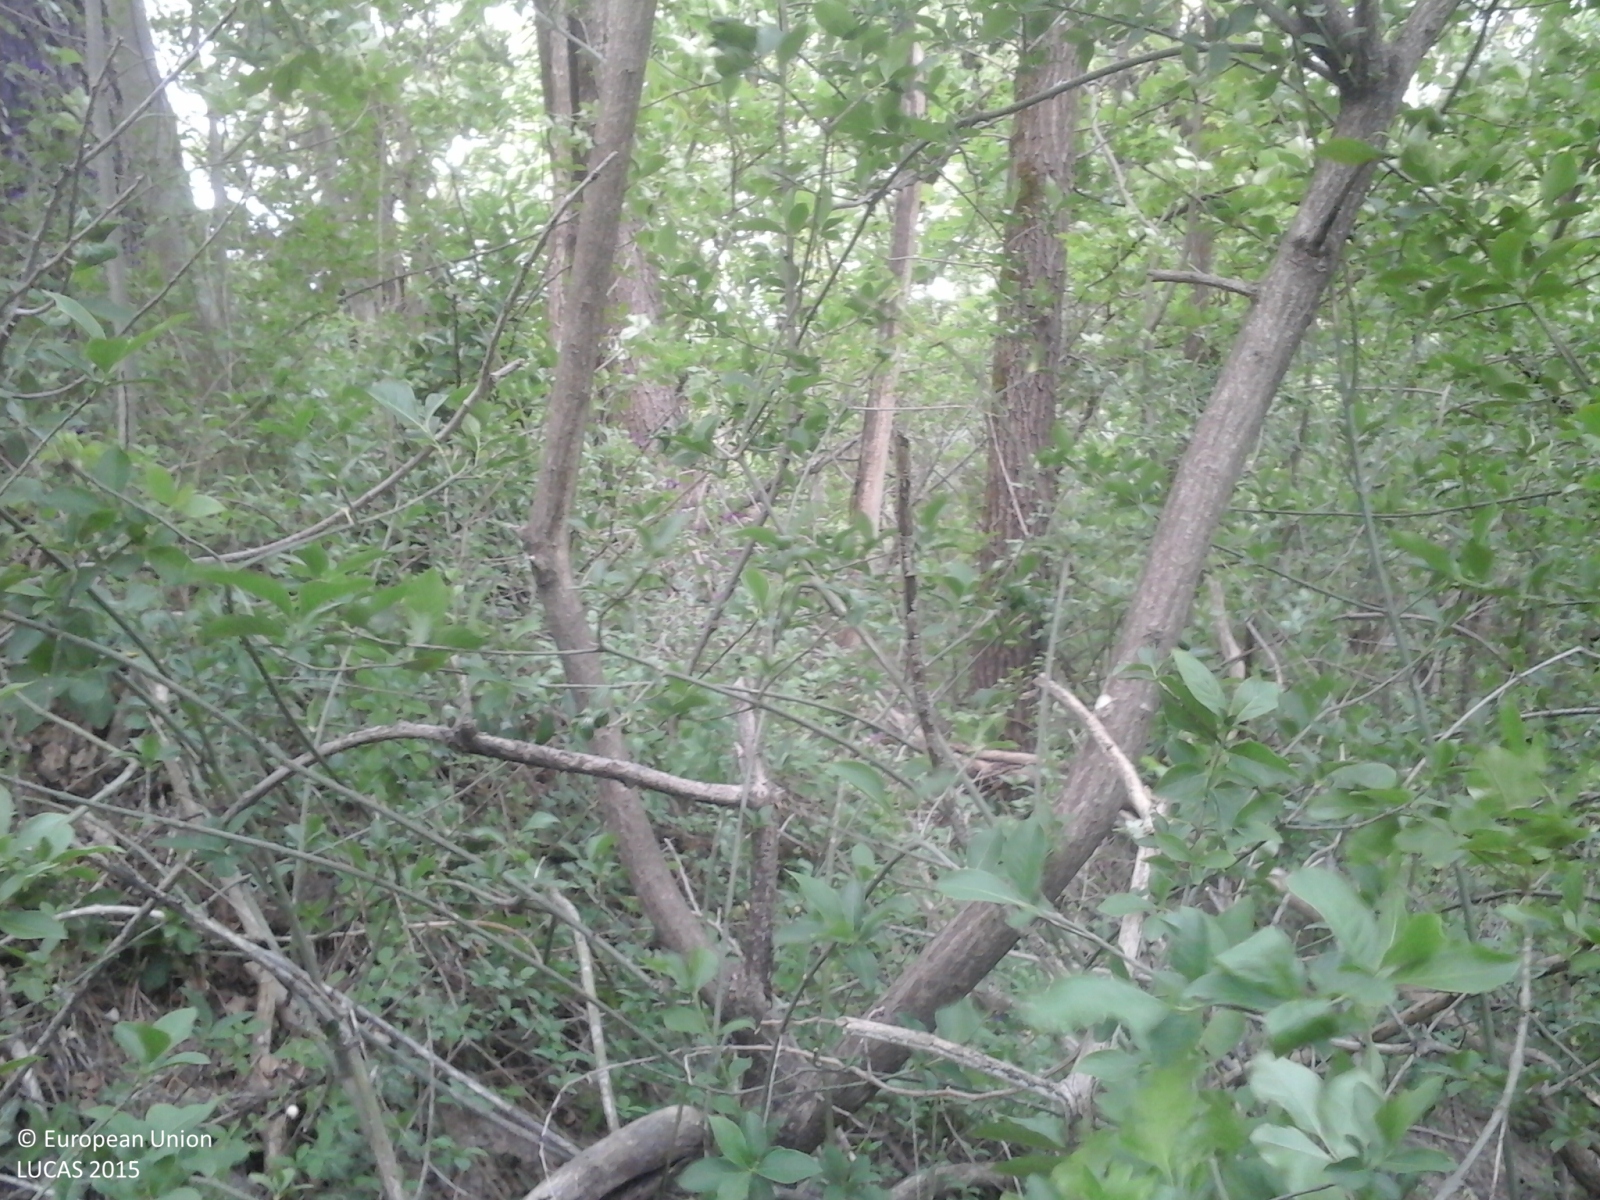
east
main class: Woodland
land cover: Broadleaved woodland
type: thermophilous deciduous forest
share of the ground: > 75 %
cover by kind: broadleaved forest trees 100 %
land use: Forestry
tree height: > 5 m
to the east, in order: Broadleaved woodland; Apple fruit; Broadleaved woodland; Apple fruit; Grassland without tree/shrub cover; Apple fruit
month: April
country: IT
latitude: 46.2737
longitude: 11.0756
